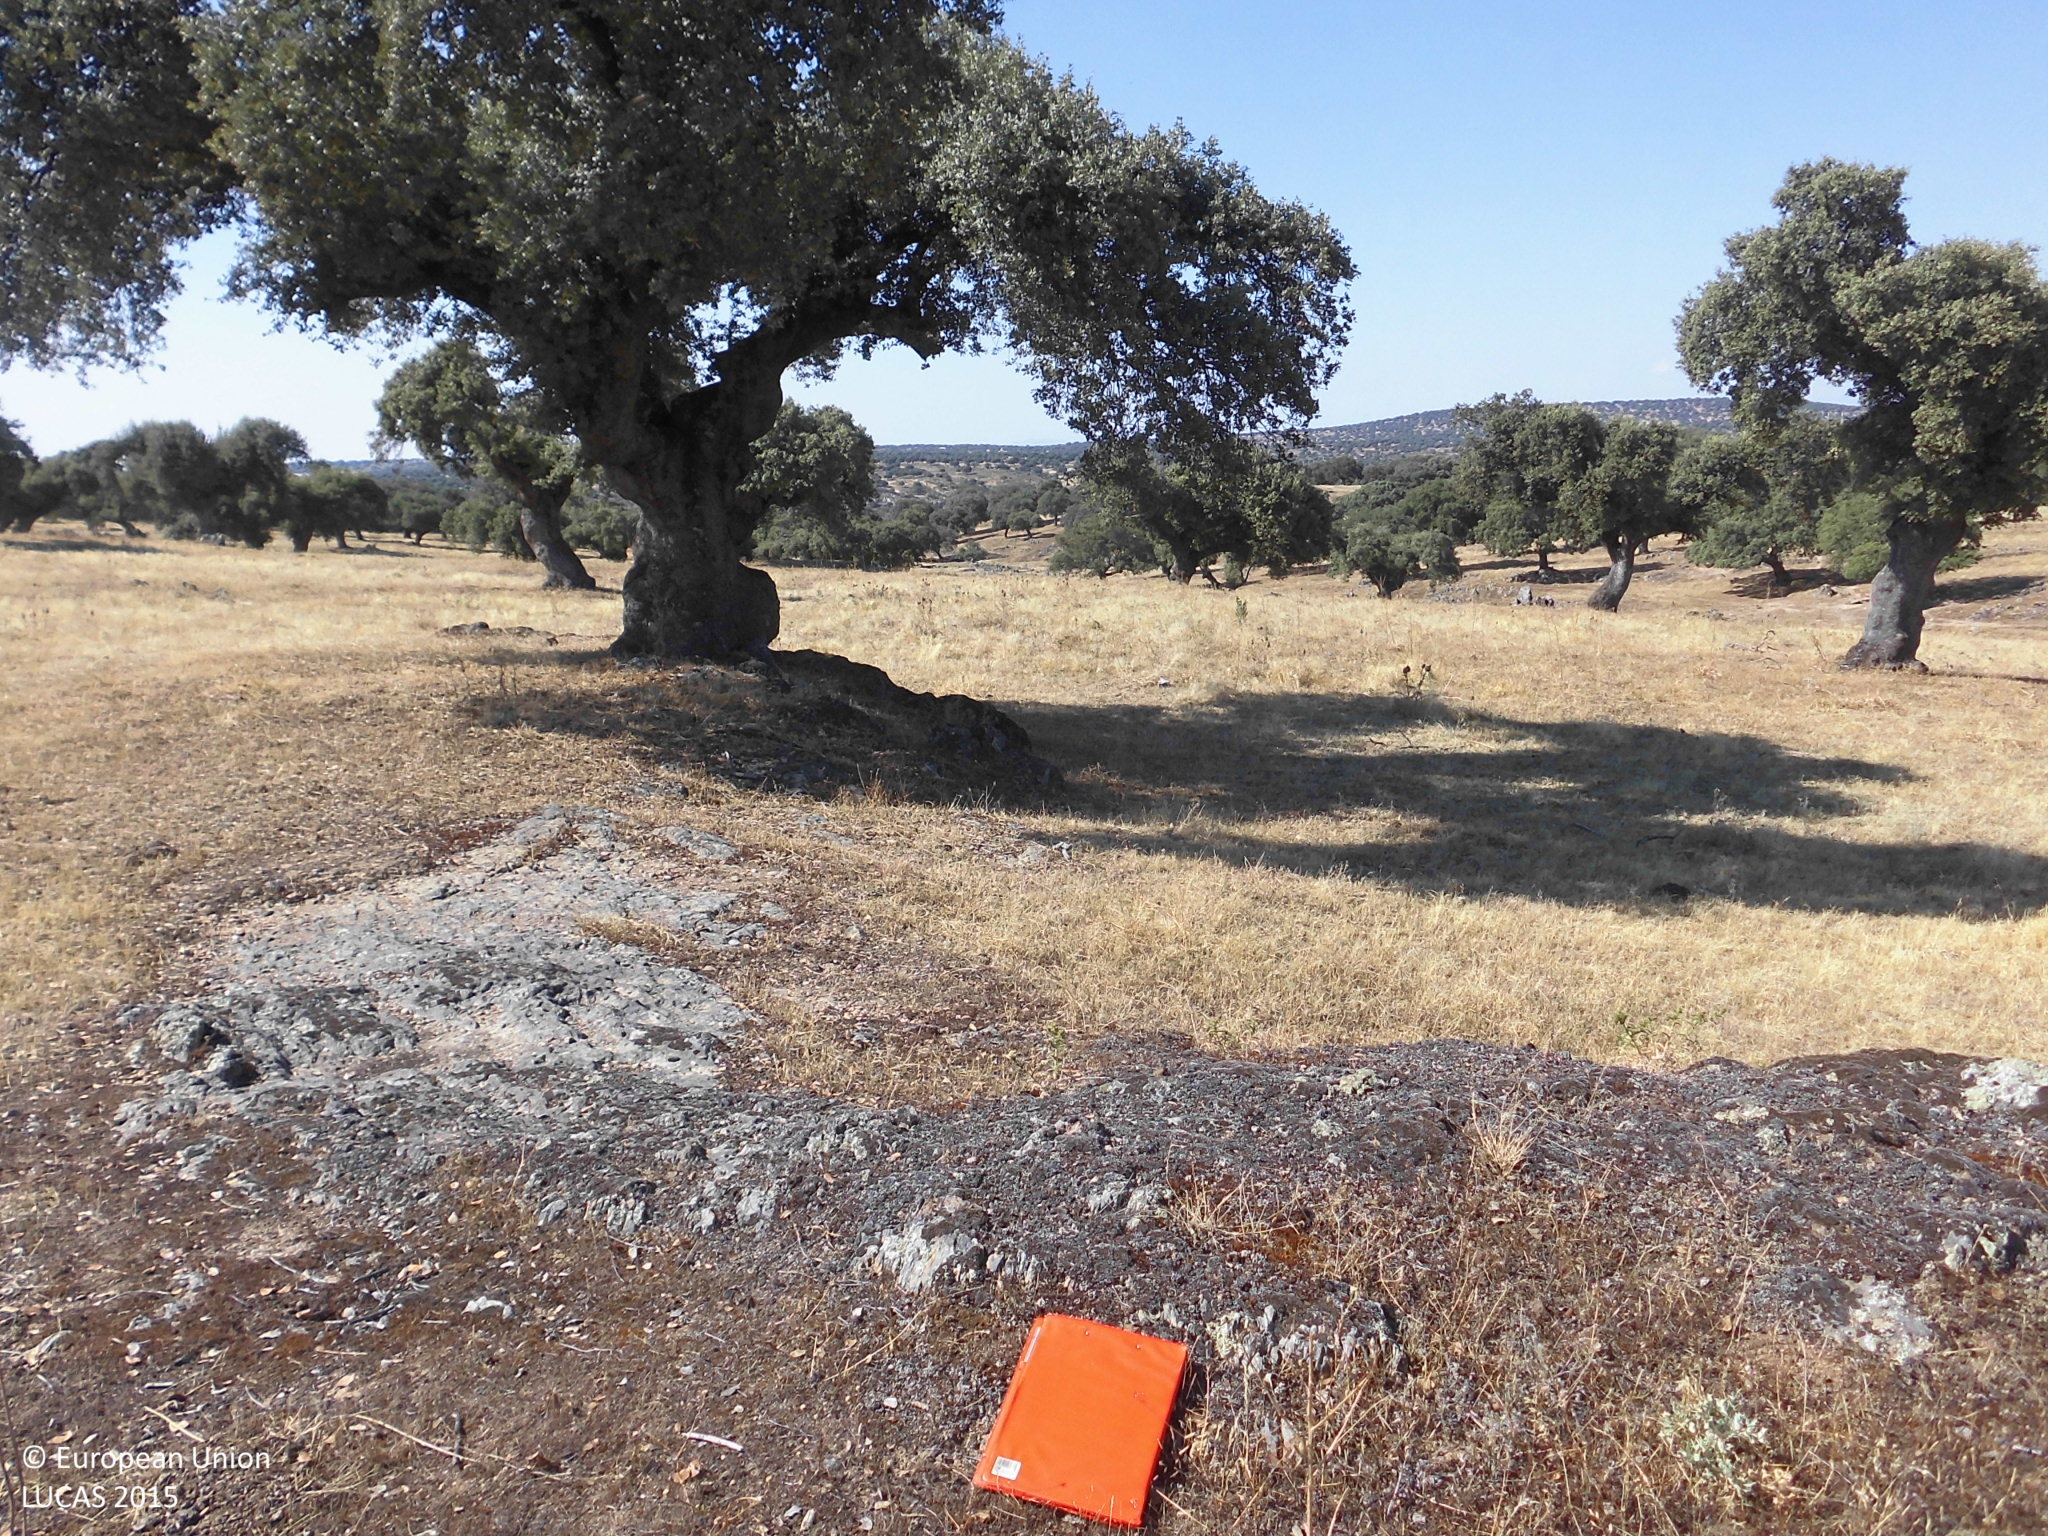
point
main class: Woodland
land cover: Broadleaved woodland
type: broadleaved evergreen forest
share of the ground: 10 - 25 %
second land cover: Grassland without tree/shrub cover
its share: > 75 %
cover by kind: herbaceous plants 80 %, broadleaved forest trees 15 %, consolidated bare surface 5 %
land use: Forestry
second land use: Agriculture (excluding fallow land and kitchen gardens)
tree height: > 5 m
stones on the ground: < 10 %
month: June
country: ES
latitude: 39.6526
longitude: -5.9476
